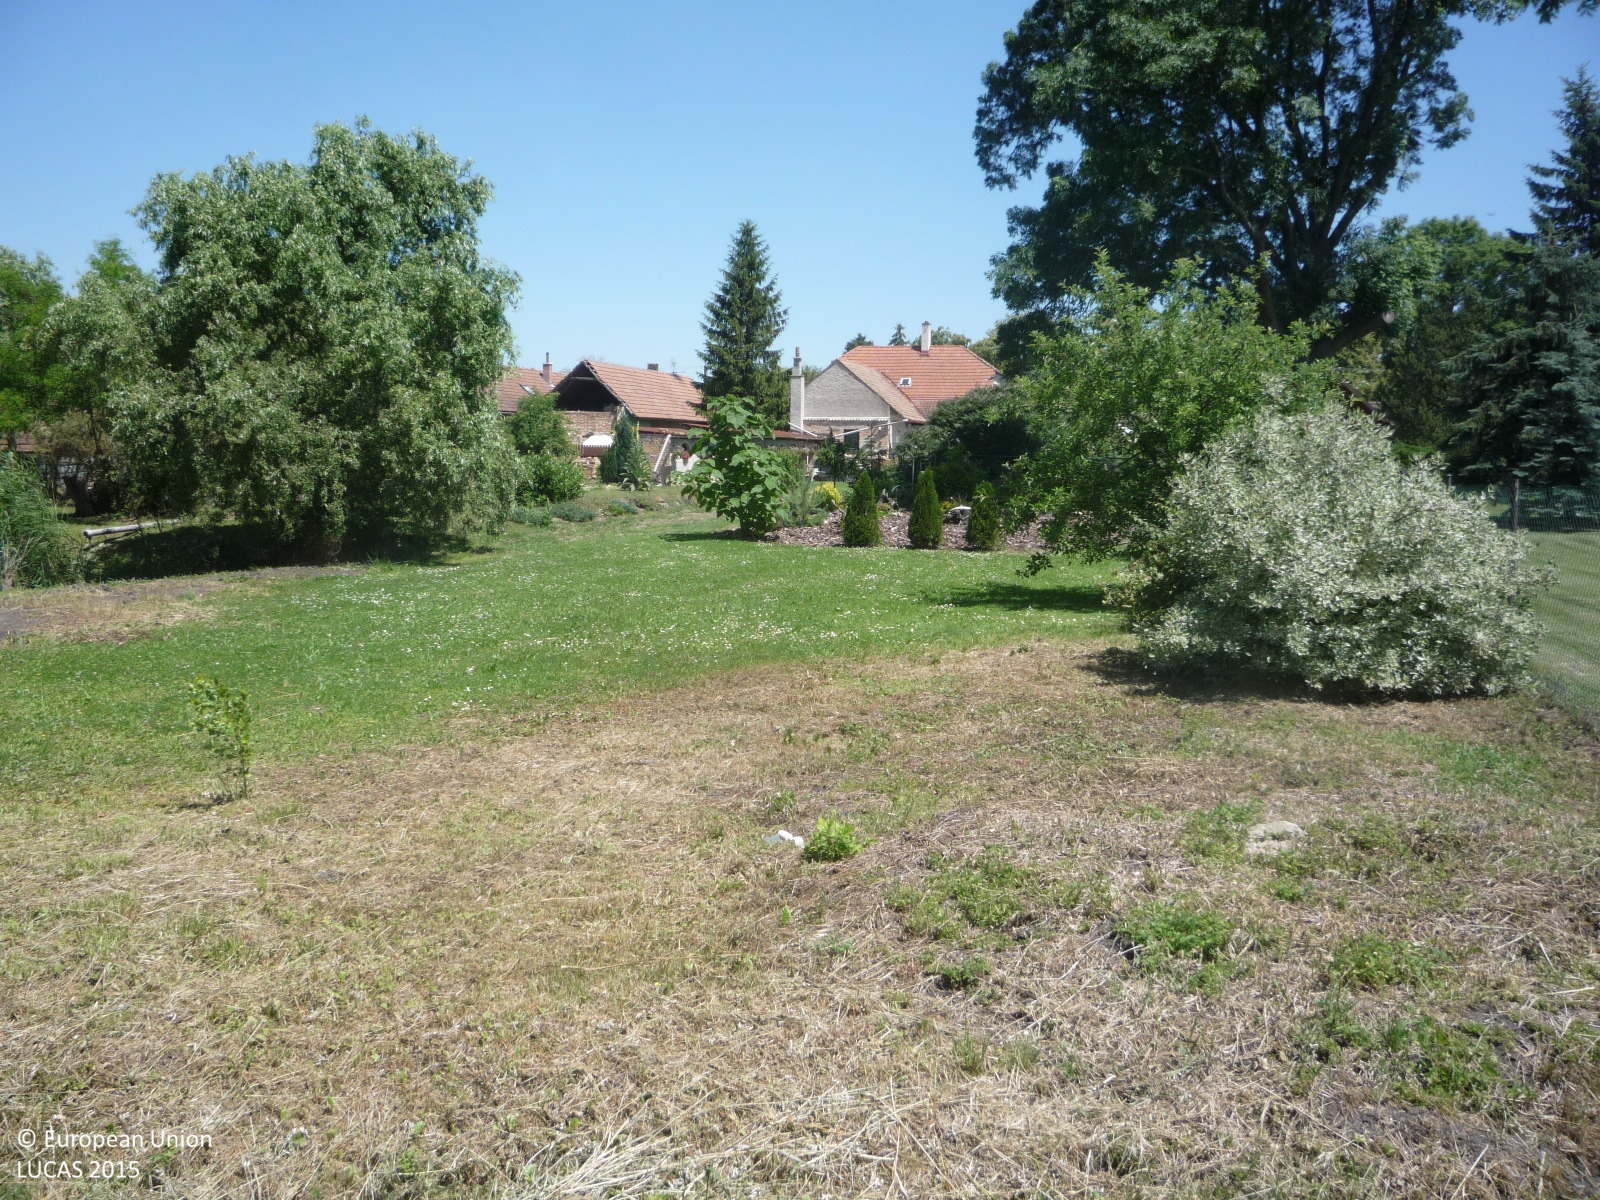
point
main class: Grassland
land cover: Grassland without tree/shrub cover
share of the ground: > 75 %
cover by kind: herbaceous plants 100 %
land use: Amenities, museums, leisure
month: July
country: CZ
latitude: 50.2648
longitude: 15.1798
